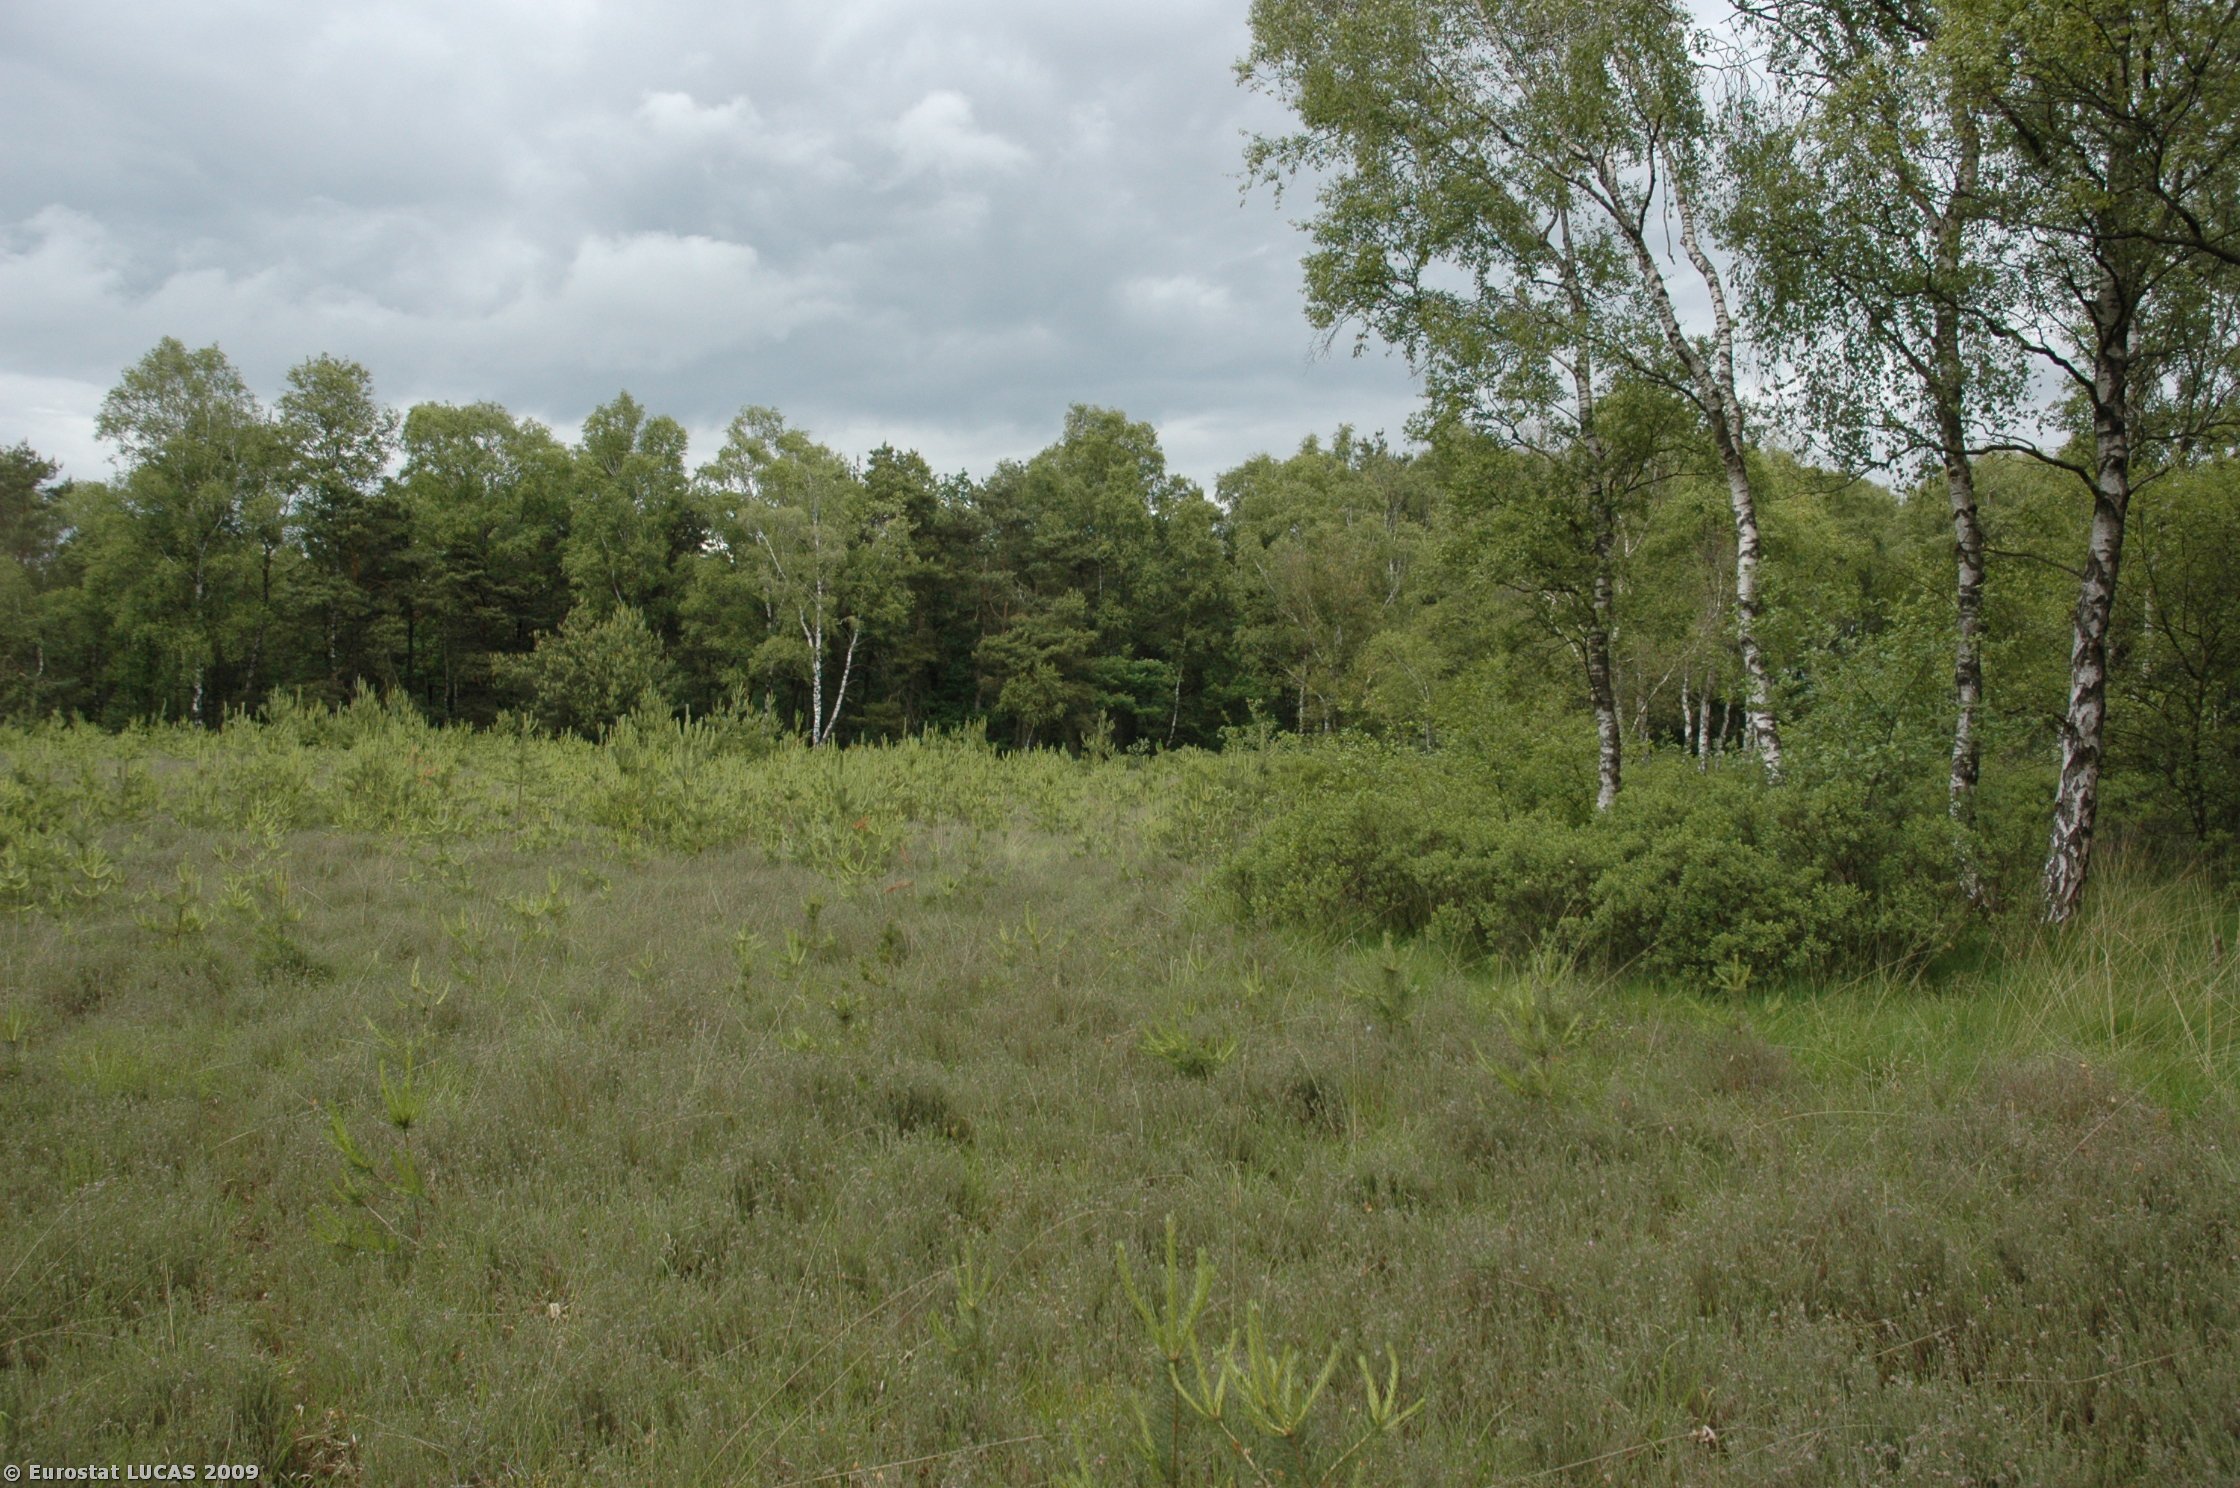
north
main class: Shrubland
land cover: Shrubland without tree cover
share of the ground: > 75 %
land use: Nature reserves
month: June
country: NL
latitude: 52.1335
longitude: 6.0985
